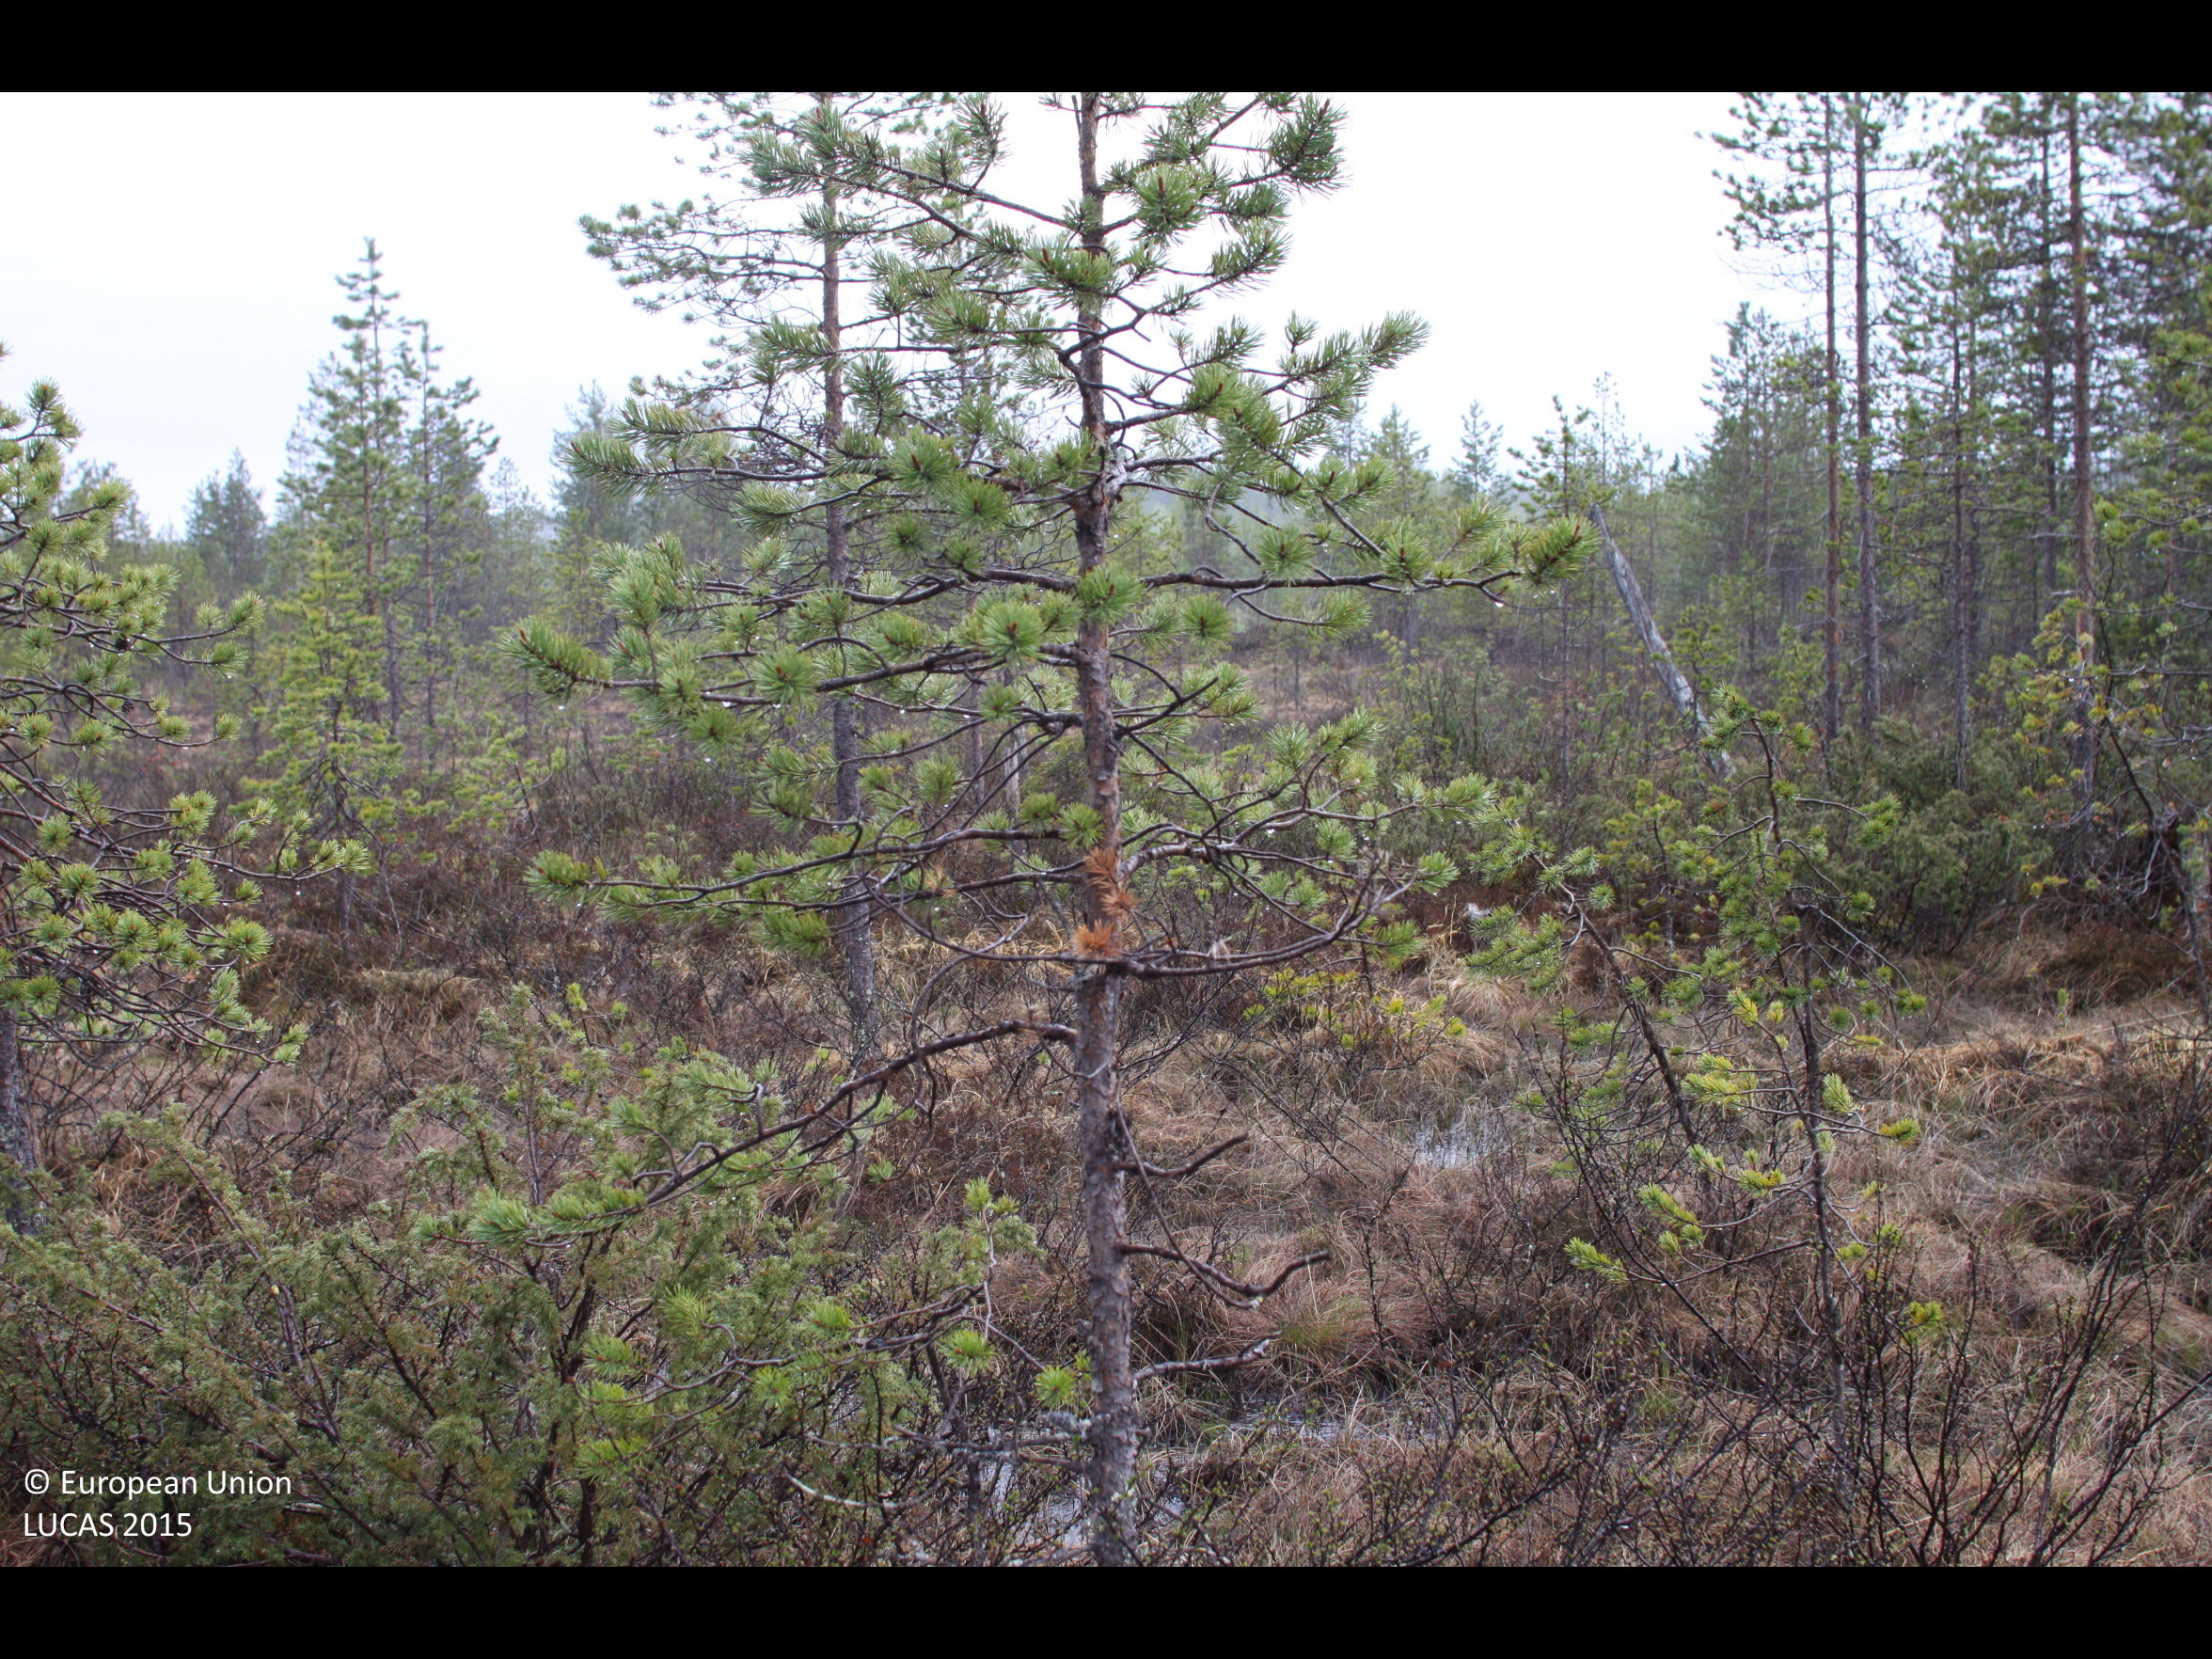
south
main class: Woodland
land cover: Pine dominated coniferous woodland
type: mire and swamp forests
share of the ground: 25 - 50 %
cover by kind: herbaceous plants 30 %, coniferous forest trees 25 %, lichens and mosses 25 %, shrubs 20 %
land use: Forestry
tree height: > 5 m
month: June
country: FI
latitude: 66.2768
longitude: 28.2506
